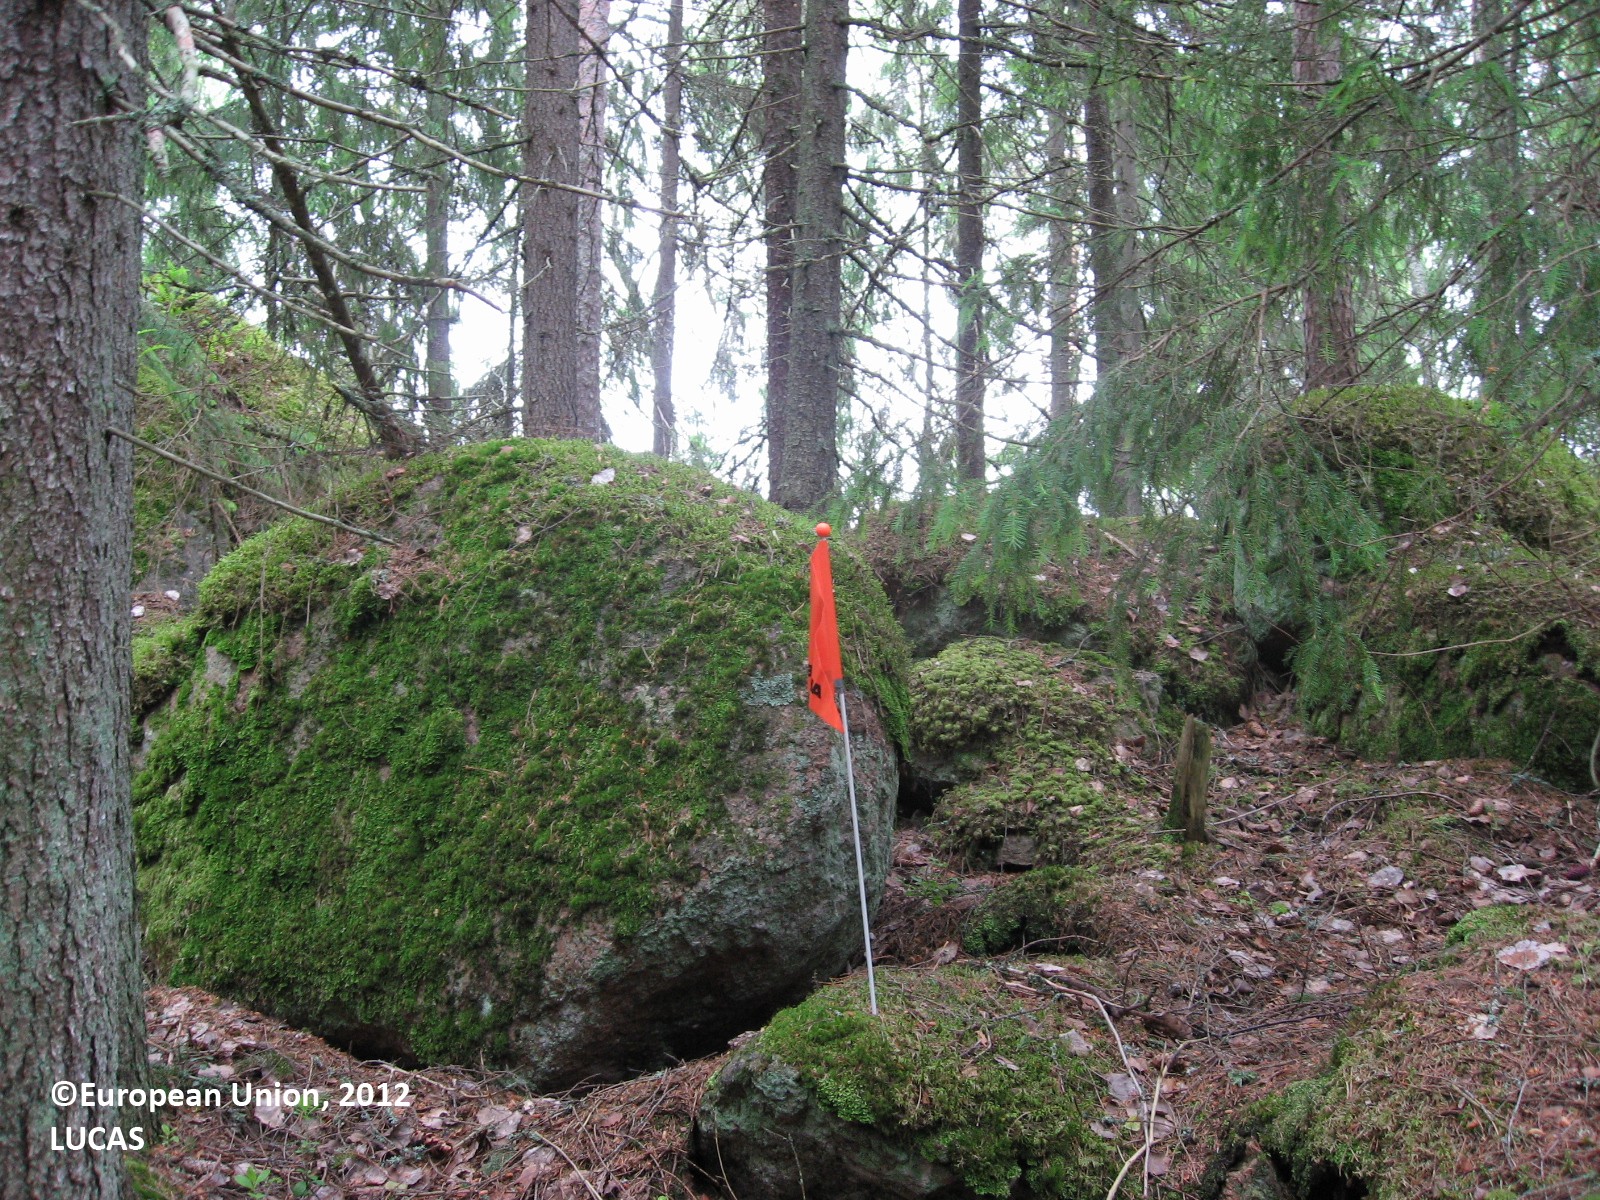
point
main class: Woodland
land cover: Spruce dominated coniferous woodland
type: boreal forest
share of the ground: > 75 %
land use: Forestry
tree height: > 5 m
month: June
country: FI
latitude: 60.4137
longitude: 26.3674
